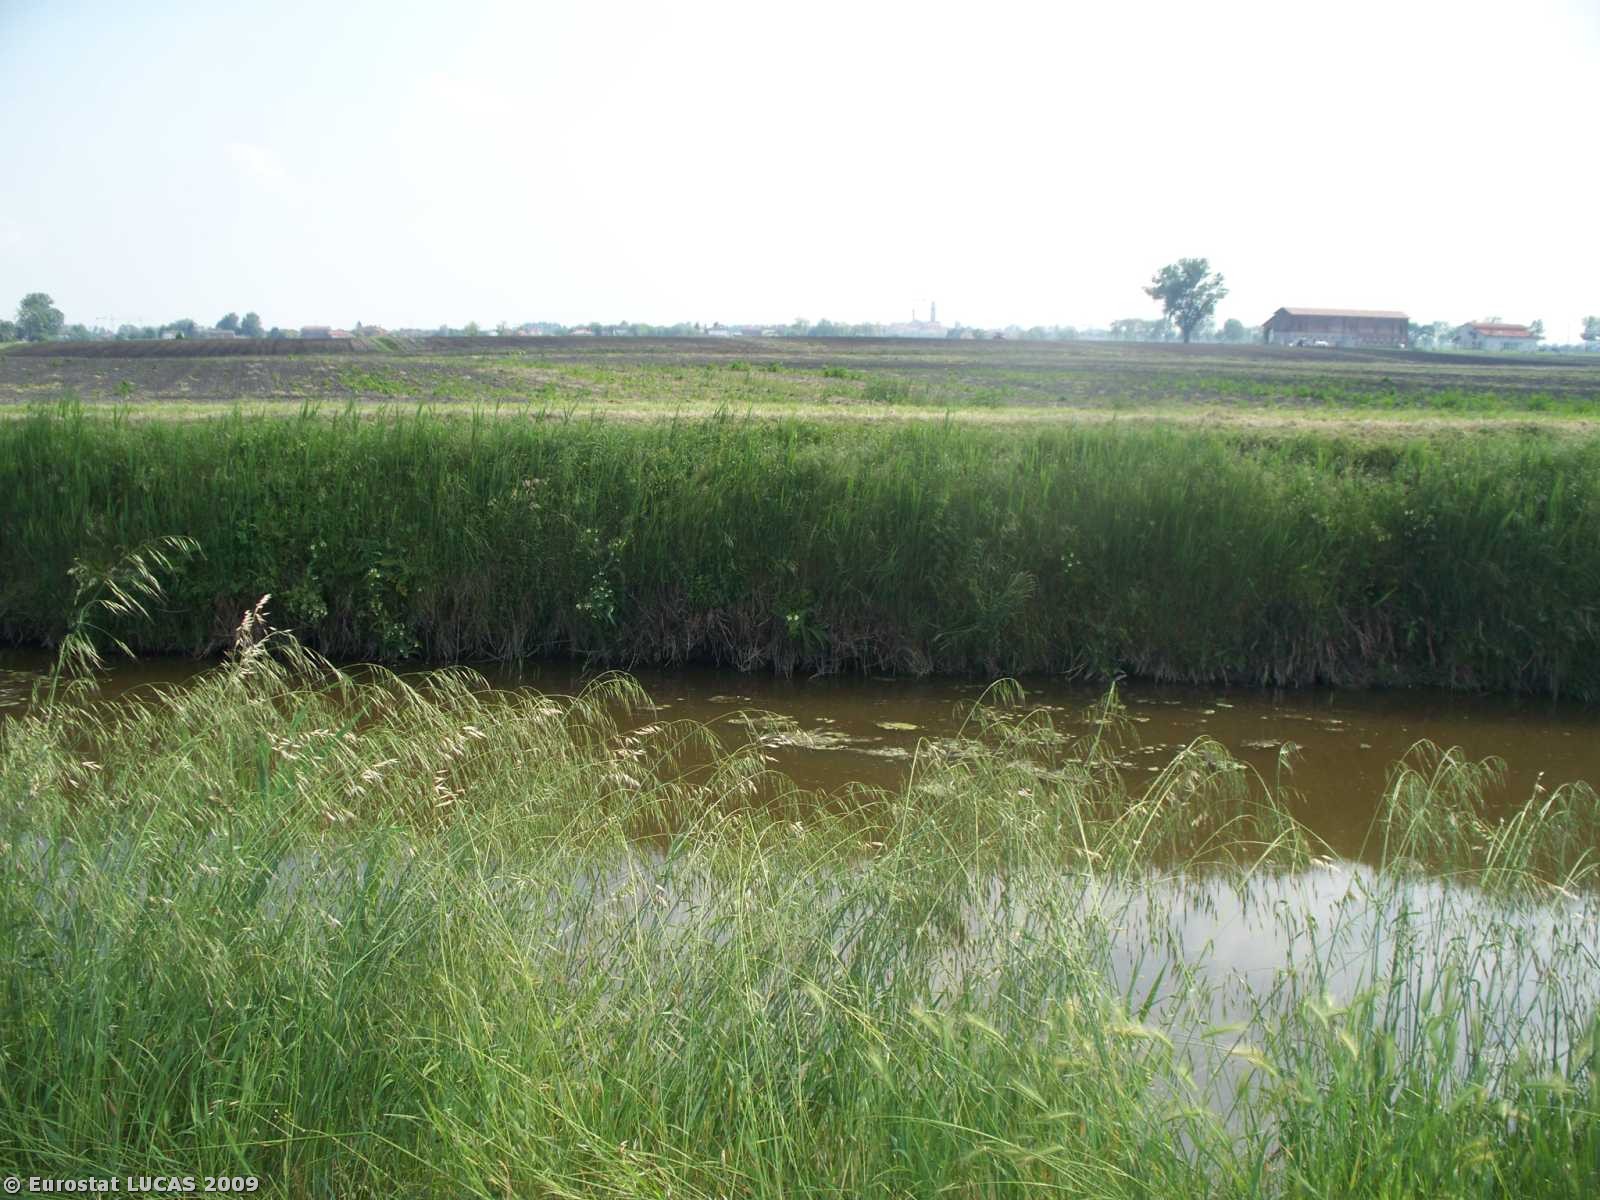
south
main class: Cropland
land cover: Common wheat
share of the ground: > 75 %
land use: Agriculture (excluding fallow land and kitchen gardens)
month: May
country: IT
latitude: 45.1591
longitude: 12.0953
